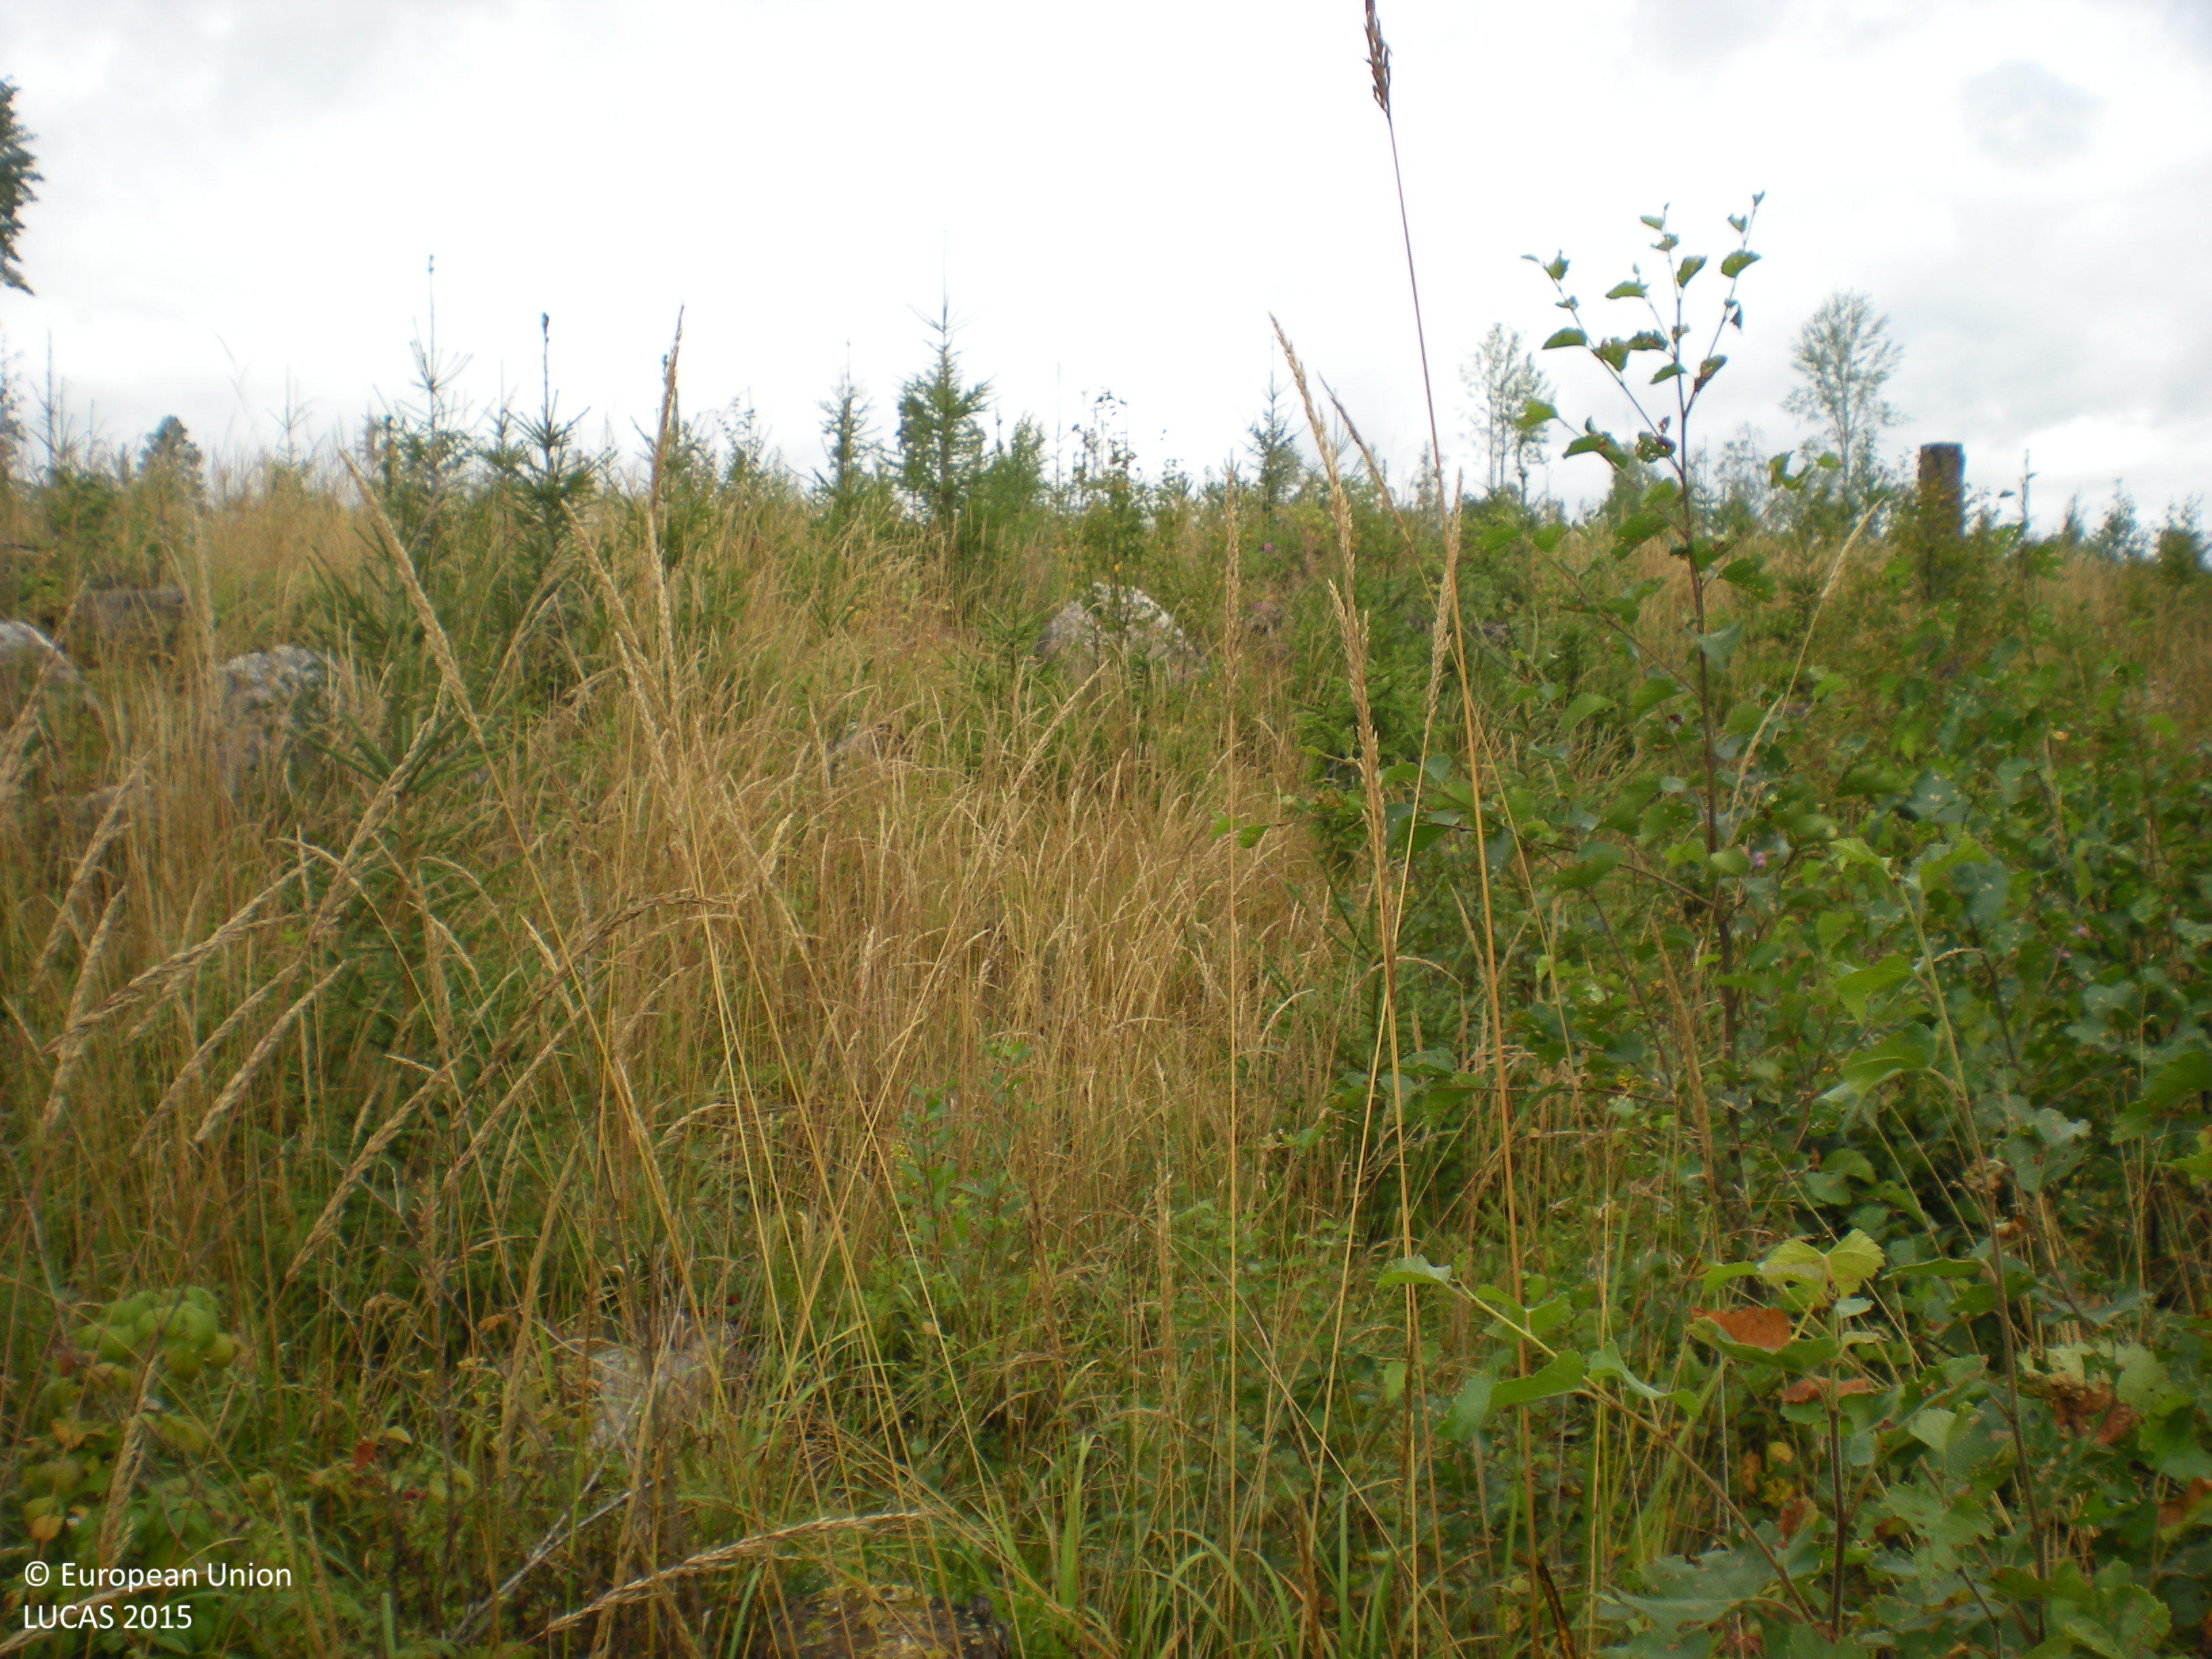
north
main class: Woodland
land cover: Spruce dominated mixed woodland
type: boreal forest
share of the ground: 50 - 75 %
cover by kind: broadleaved forest trees 35 %, coniferous forest trees 30 %, herbaceous plants 25 %, shrubs 5 %, lichens and mosses 5 %
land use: Forestry
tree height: < 5 m
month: August
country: SE
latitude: 60.4807
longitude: 17.2864
